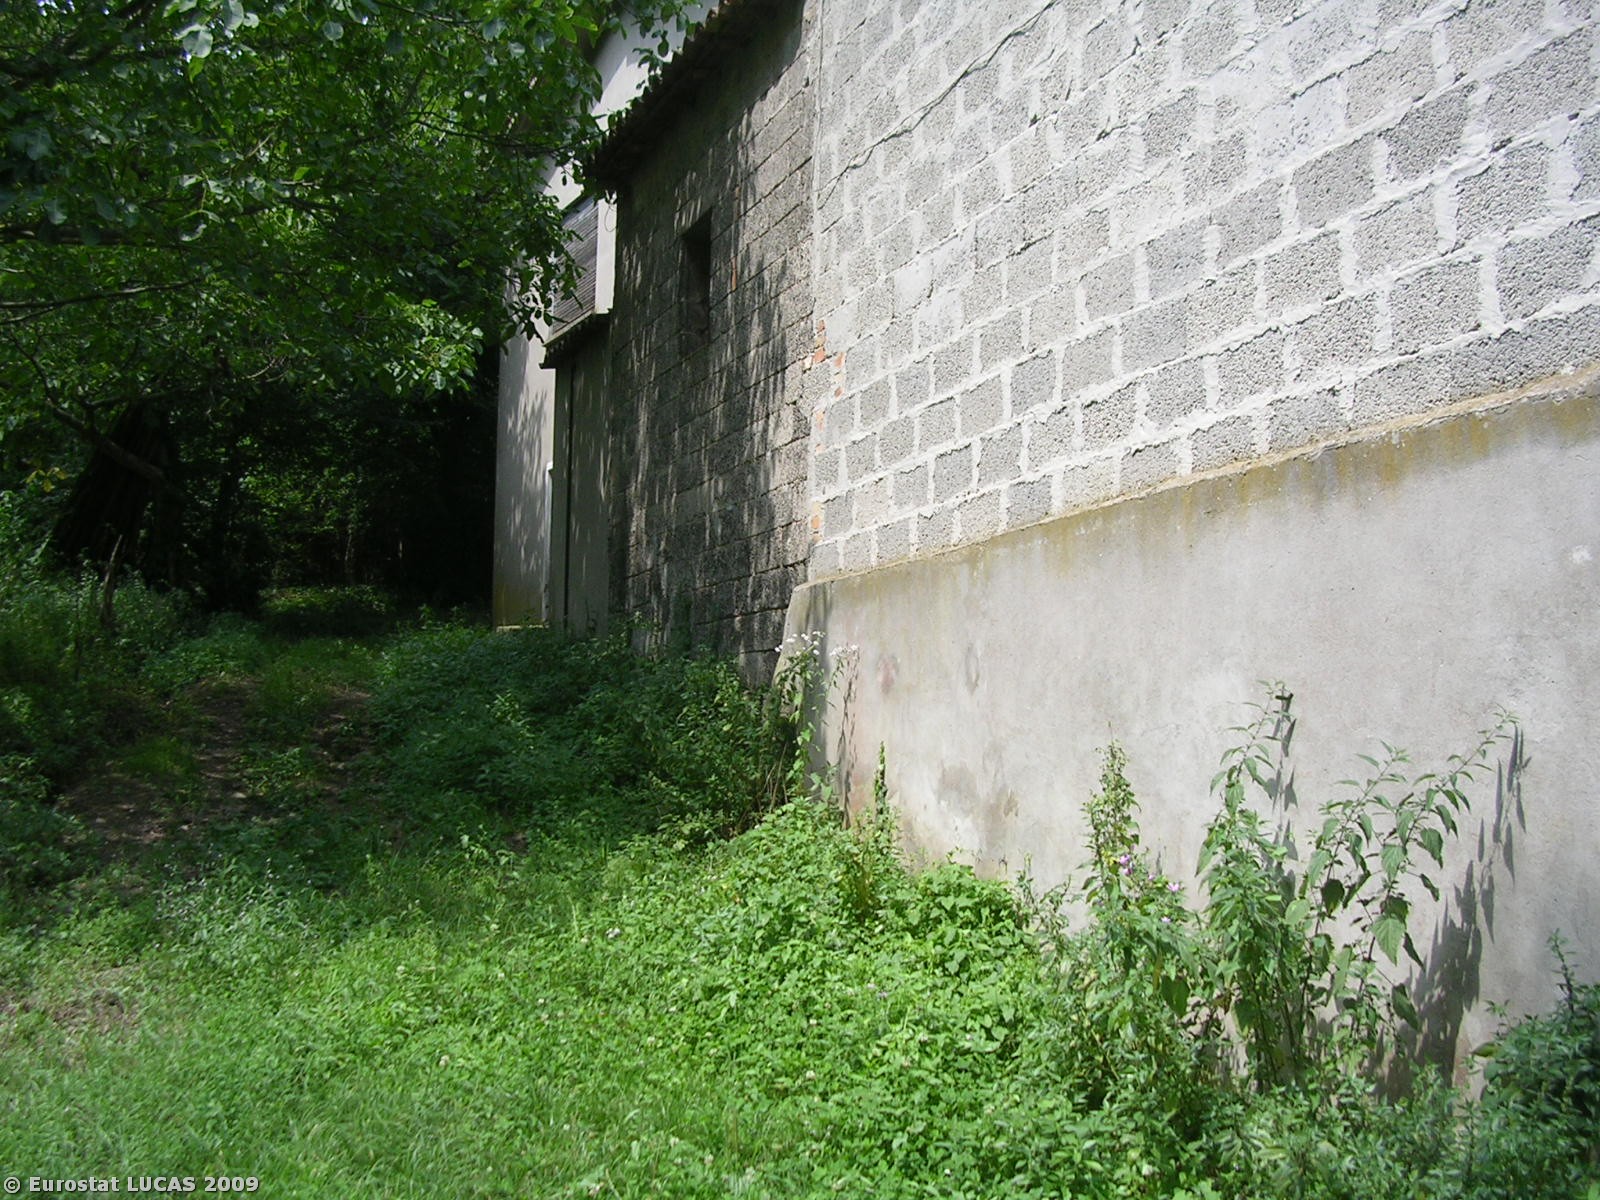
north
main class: Woodland
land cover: Mixed woodland
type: mesophytic deciduous forest
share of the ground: > 75 %
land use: Forestry
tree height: > 5 m
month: July
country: IT
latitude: 45.3102
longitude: 11.7189
